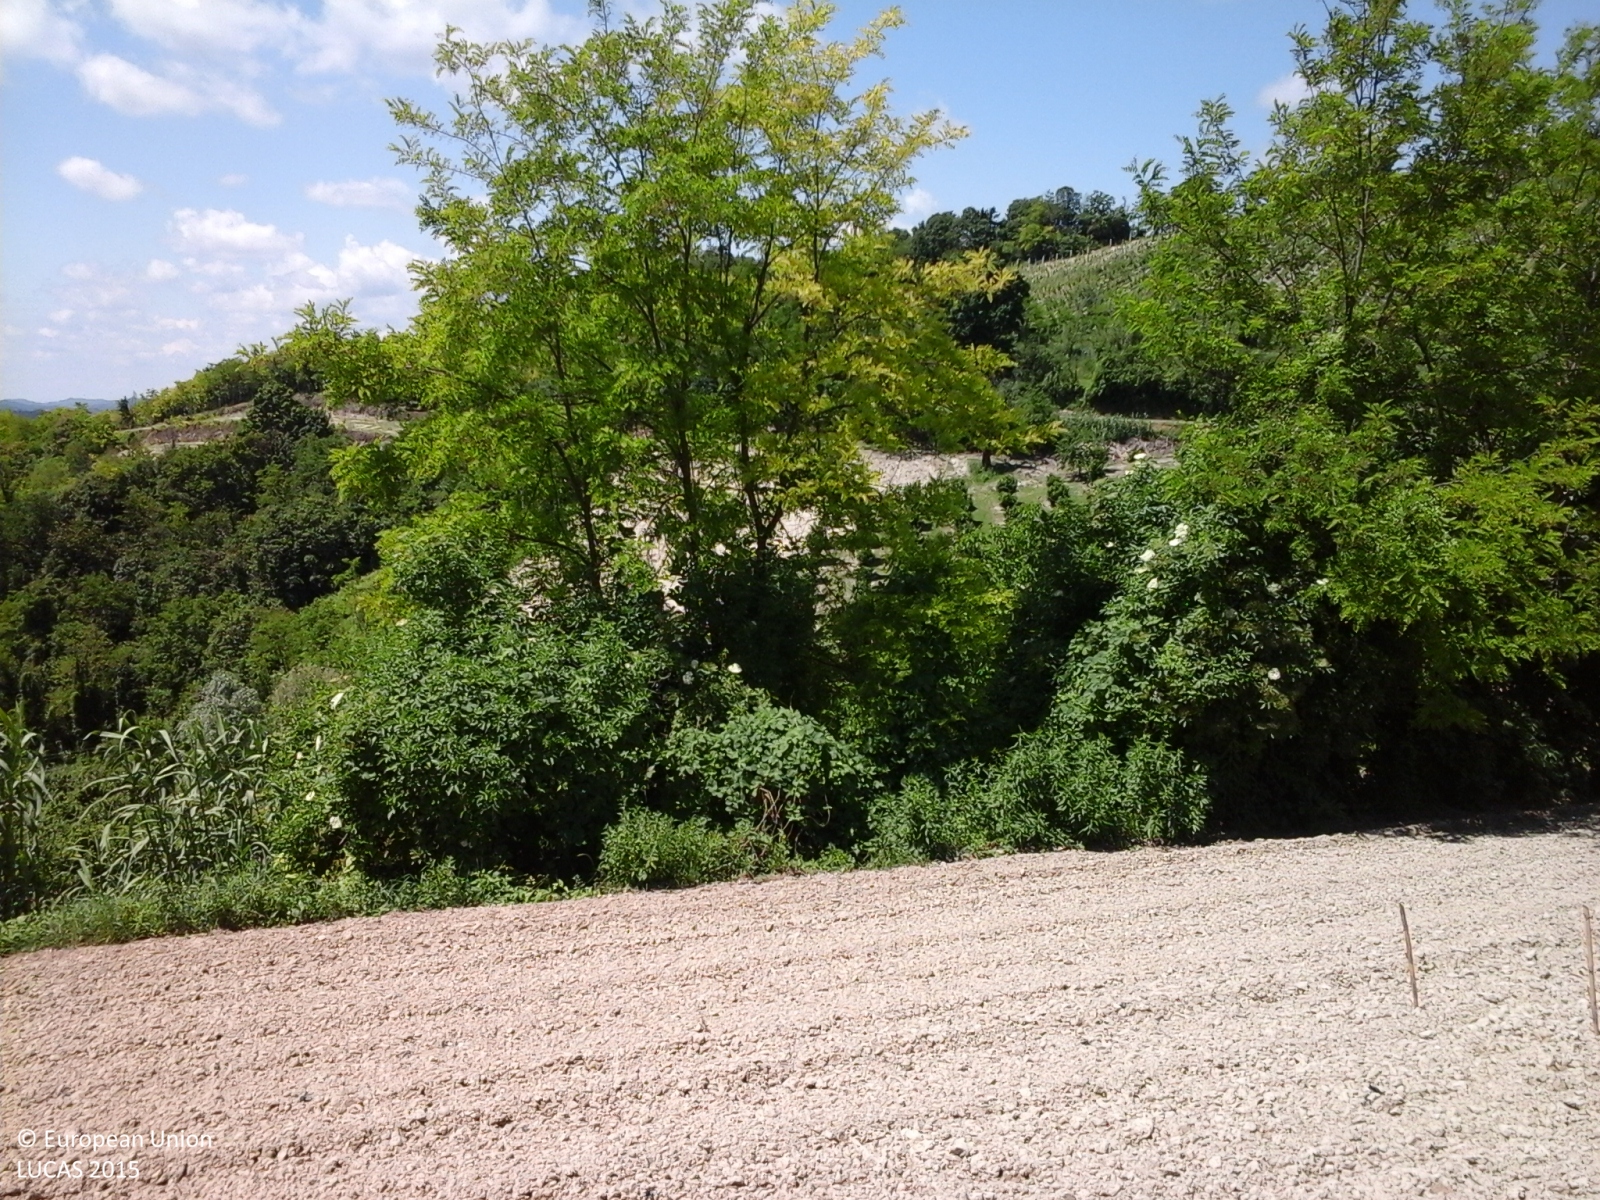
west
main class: Grassland
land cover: Spontaneously vegetated surfaces
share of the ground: > 75 %
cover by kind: herbaceous plants 70 %, unconsolidated bare surface 30 %
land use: Agriculture (excluding fallow land and kitchen gardens)
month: May
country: IT
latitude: 45.1471
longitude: 8.2353
